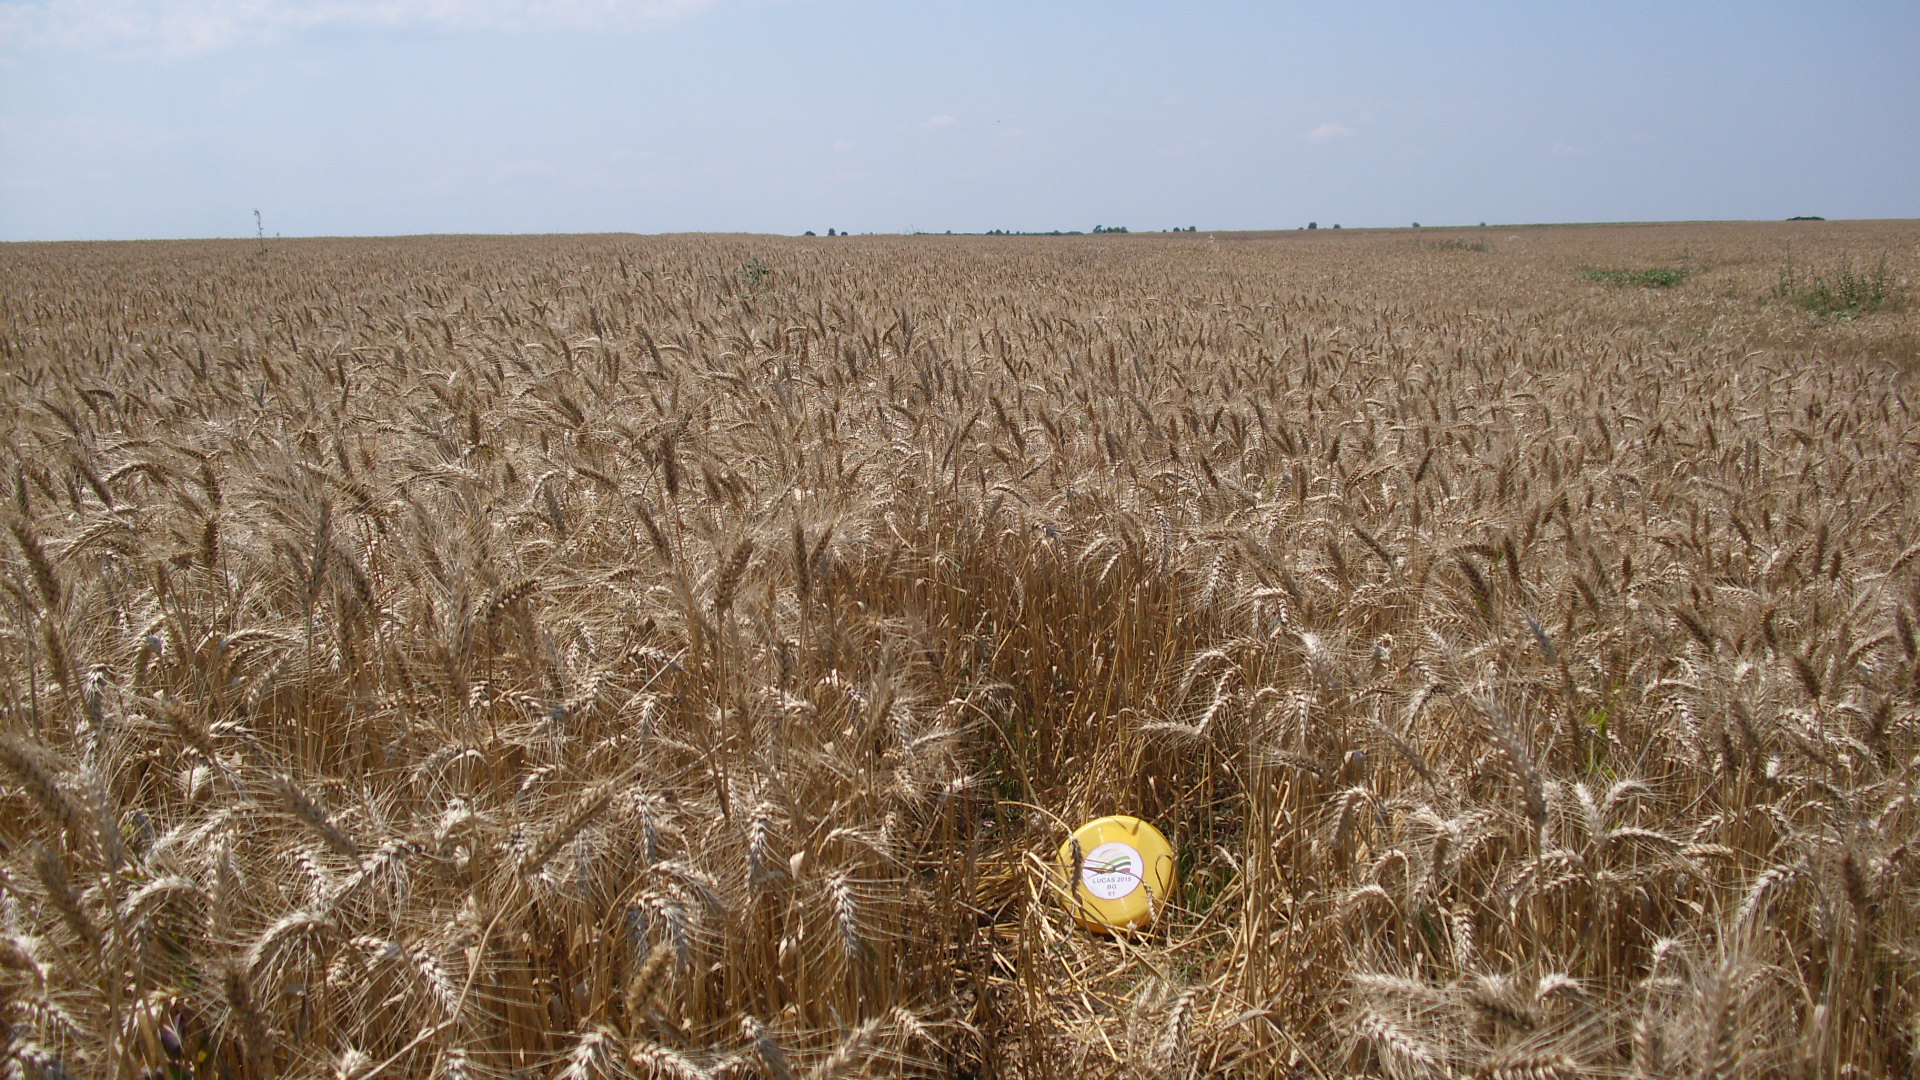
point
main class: Cropland
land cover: Common wheat
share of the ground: > 75 %
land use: Agriculture (excluding fallow land and kitchen gardens)
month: June
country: BG
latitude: 43.6225
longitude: 23.2650
